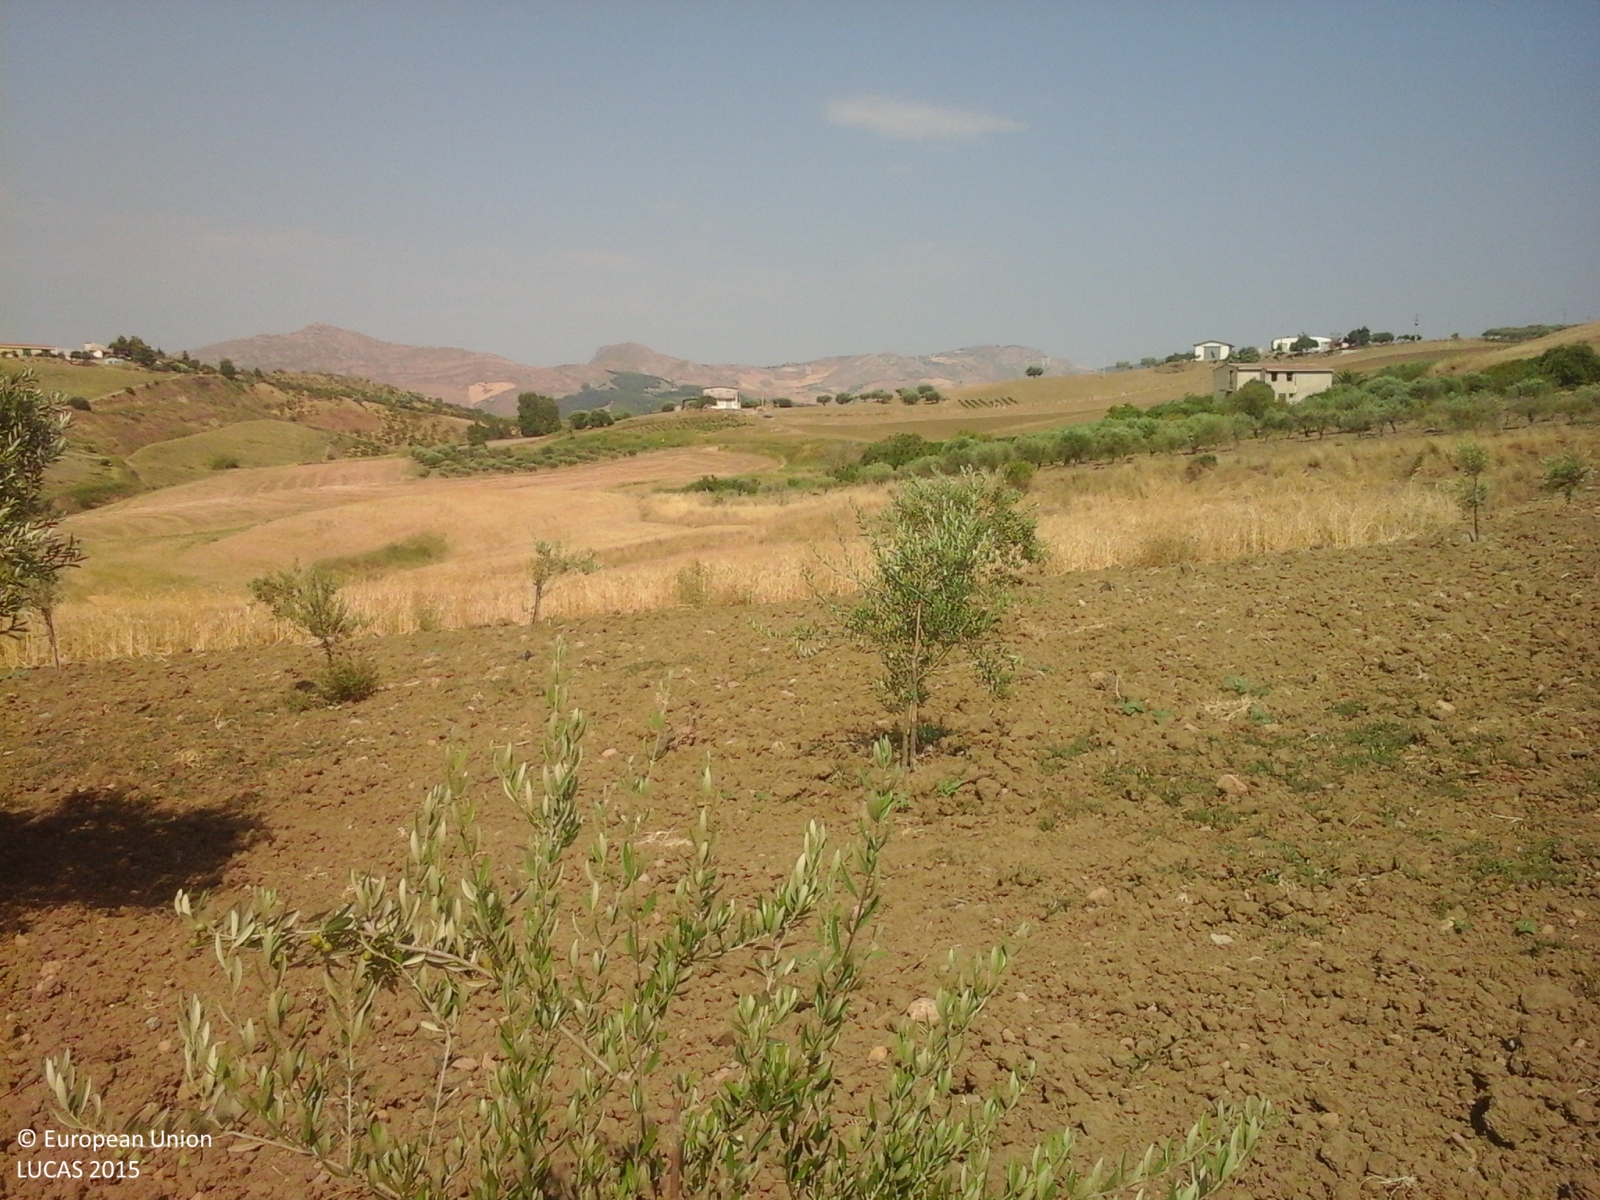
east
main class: Cropland
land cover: Olive groves
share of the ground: 25 - 50 %
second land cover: Other bare soil
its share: > 75 %
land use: Agriculture (excluding fallow land and kitchen gardens)
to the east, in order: Olive groves; Other bare soil; Grass margins; Barley; Grass margins; Tracks; Grass margins; Olive groves; Fences; Spontaneously vegetated surfaces; Other fruit trees and berries
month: July
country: IT
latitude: 37.4604
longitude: 13.6241
